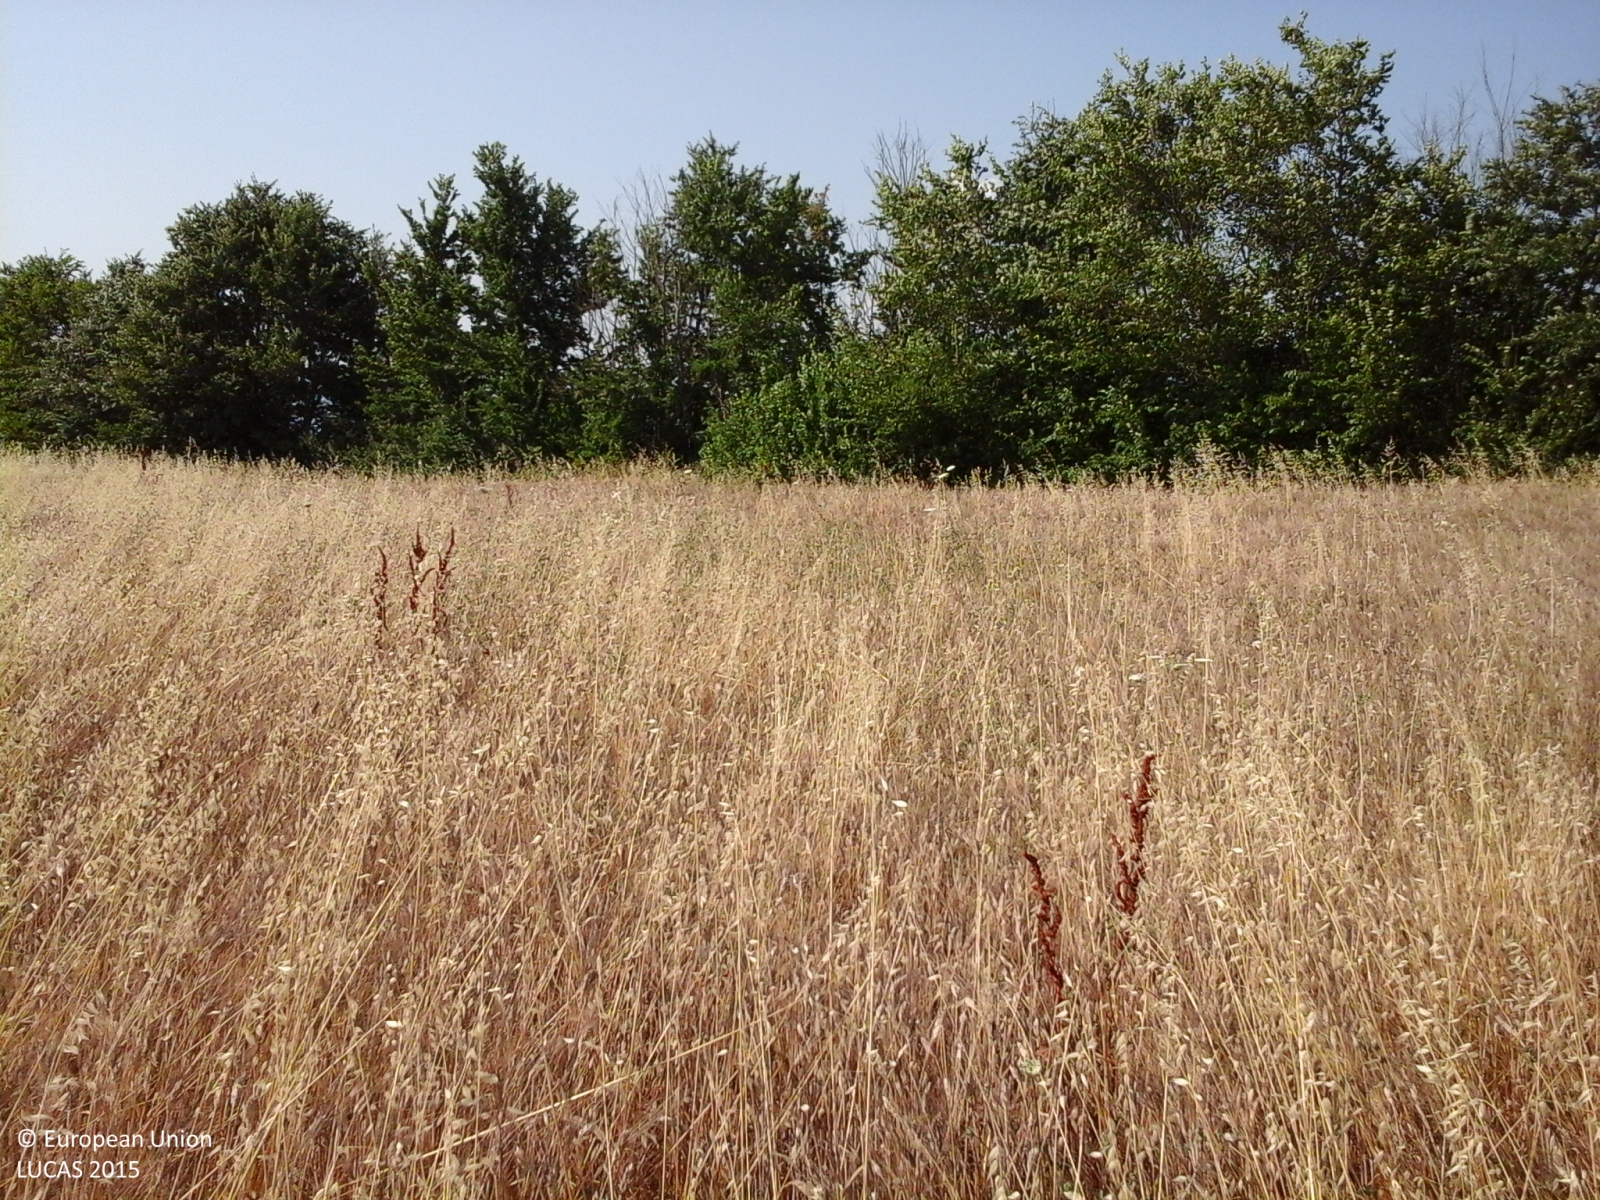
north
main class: Cropland
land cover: Durum wheat
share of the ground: > 75 %
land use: Agriculture (excluding fallow land and kitchen gardens)
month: July
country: IT
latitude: 41.4225
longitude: 14.7094
